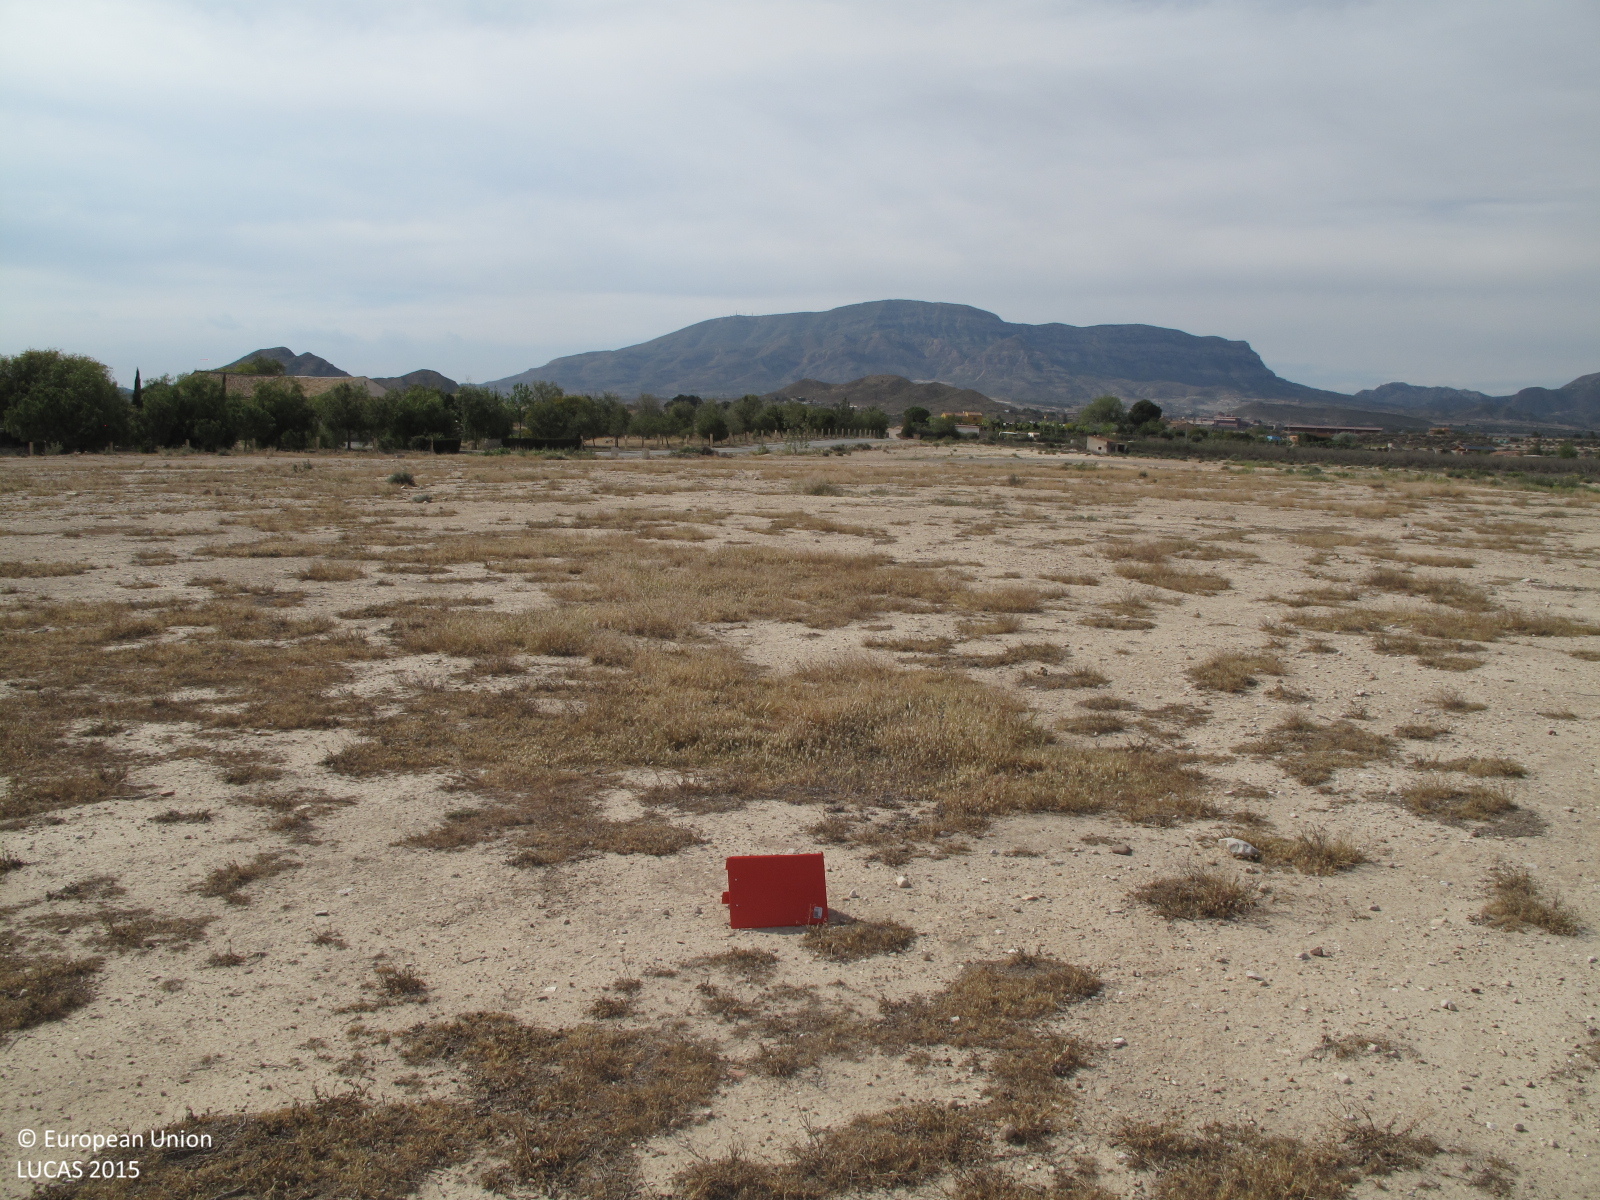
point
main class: Grassland
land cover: Grassland without tree/shrub cover
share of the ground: 10 - 25 %
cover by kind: consolidated bare surface 80 %, herbaceous plants 20 %
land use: Semi-natural and natural areas not in use
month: April
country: ES
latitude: 38.4087
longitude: -0.6485
